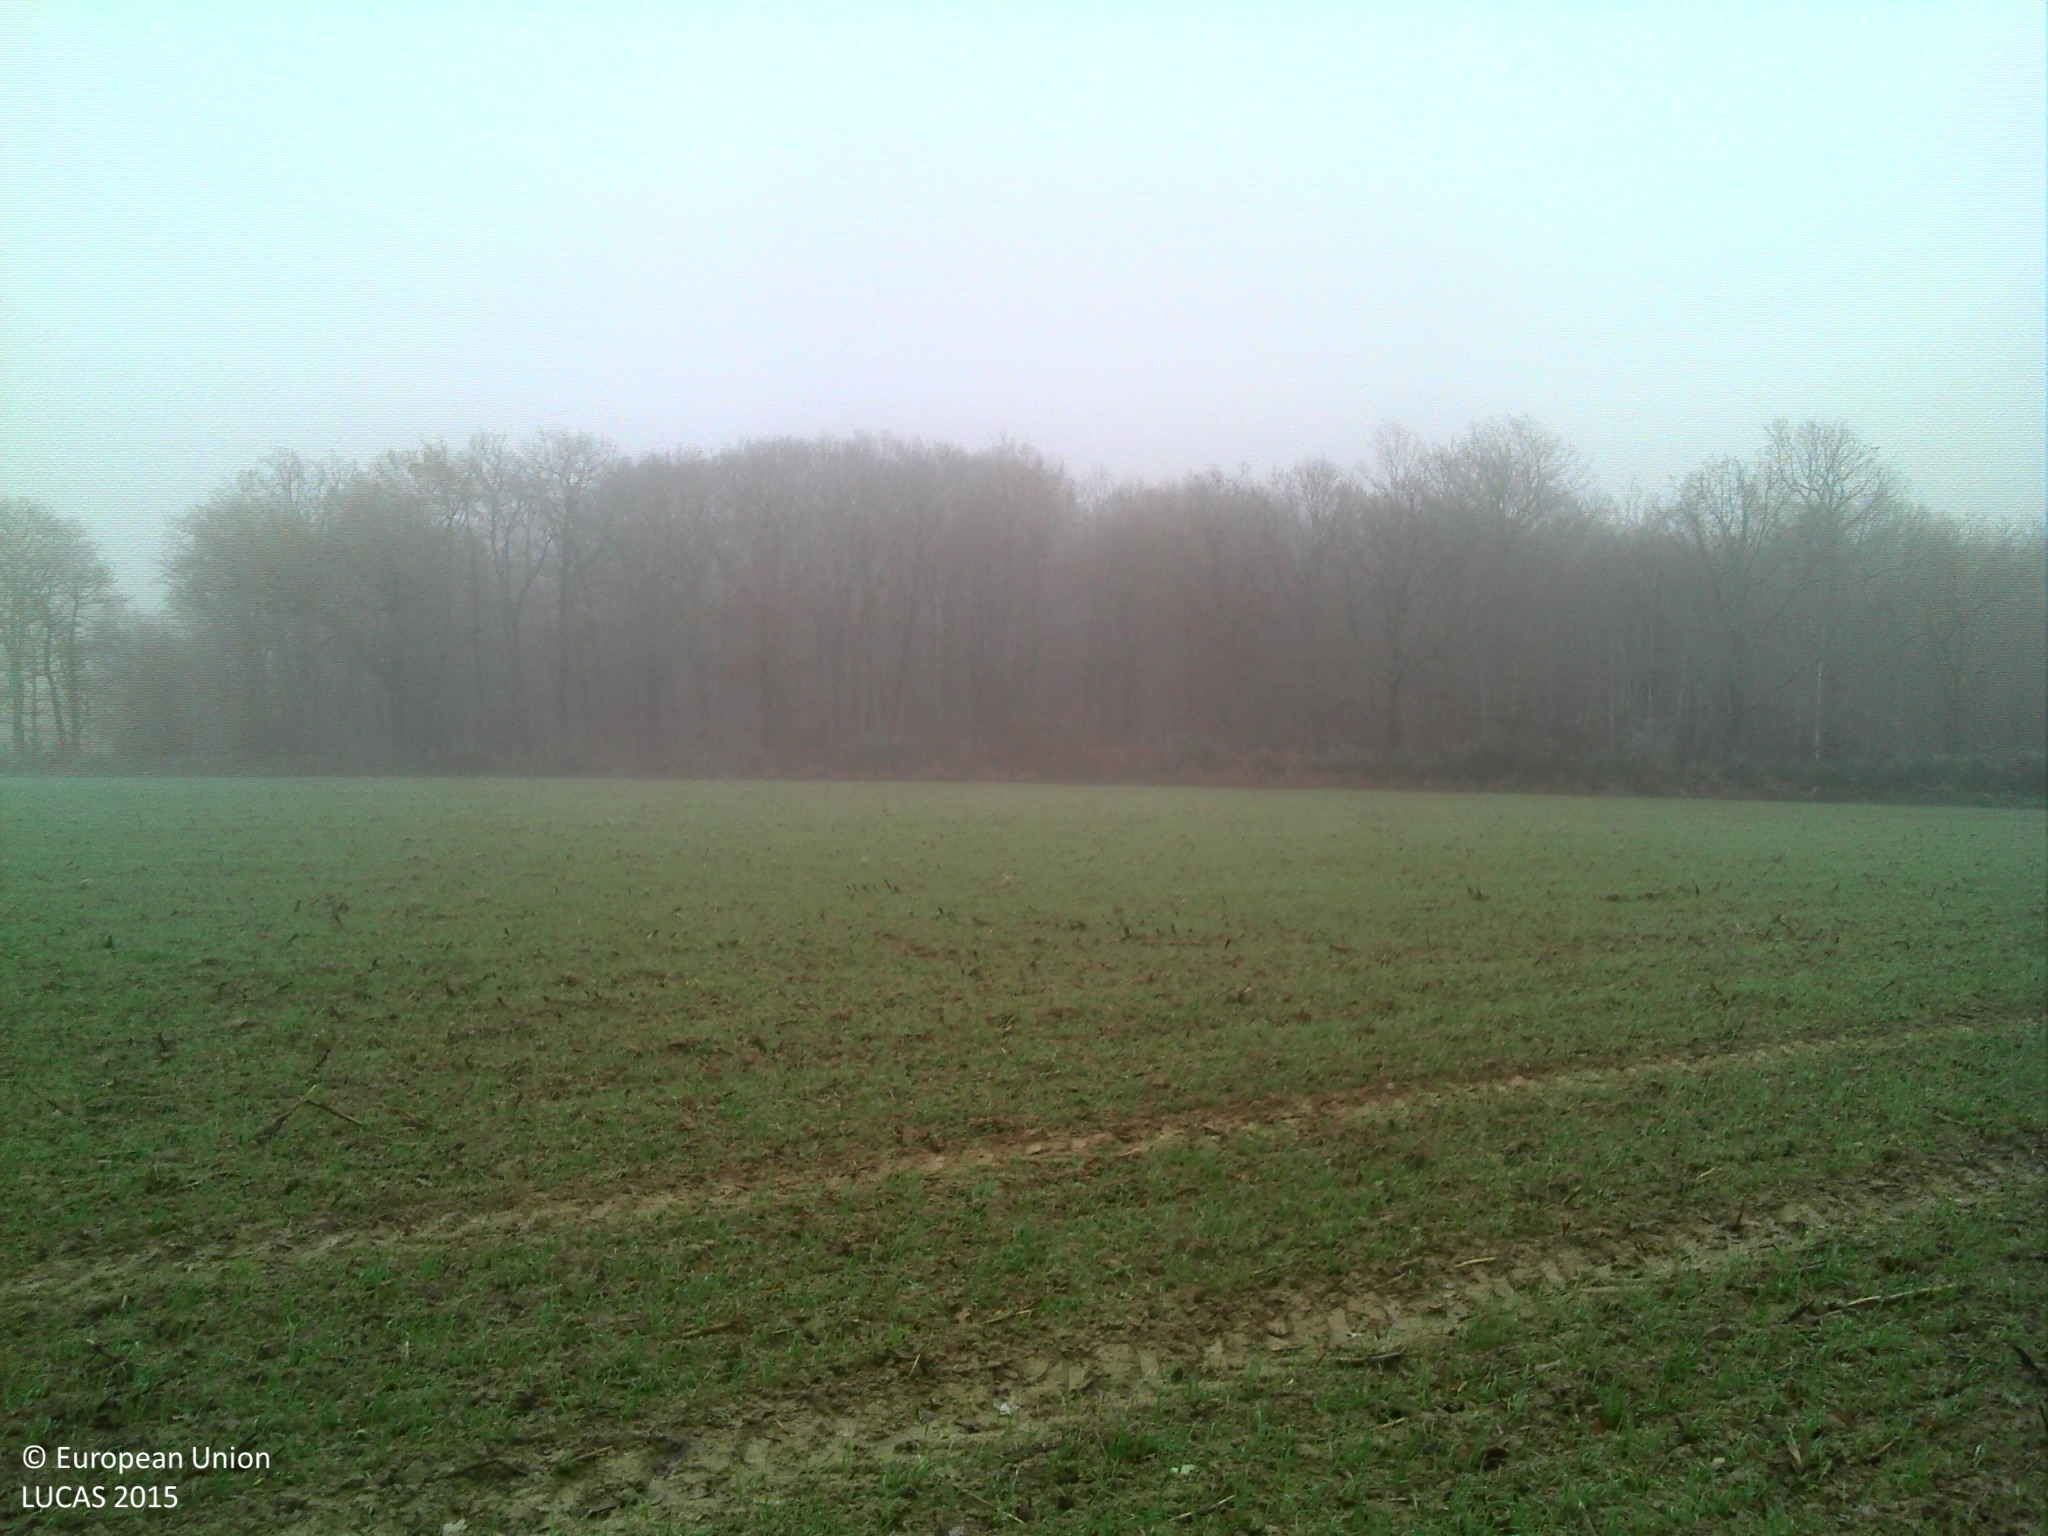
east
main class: Cropland
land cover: Common wheat
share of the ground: 50 - 75 %
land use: Agriculture (excluding fallow land and kitchen gardens)
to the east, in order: Common wheat; Ditches and canals; Broadleaved woodland
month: November
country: FR
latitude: 46.5418
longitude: 3.6486
